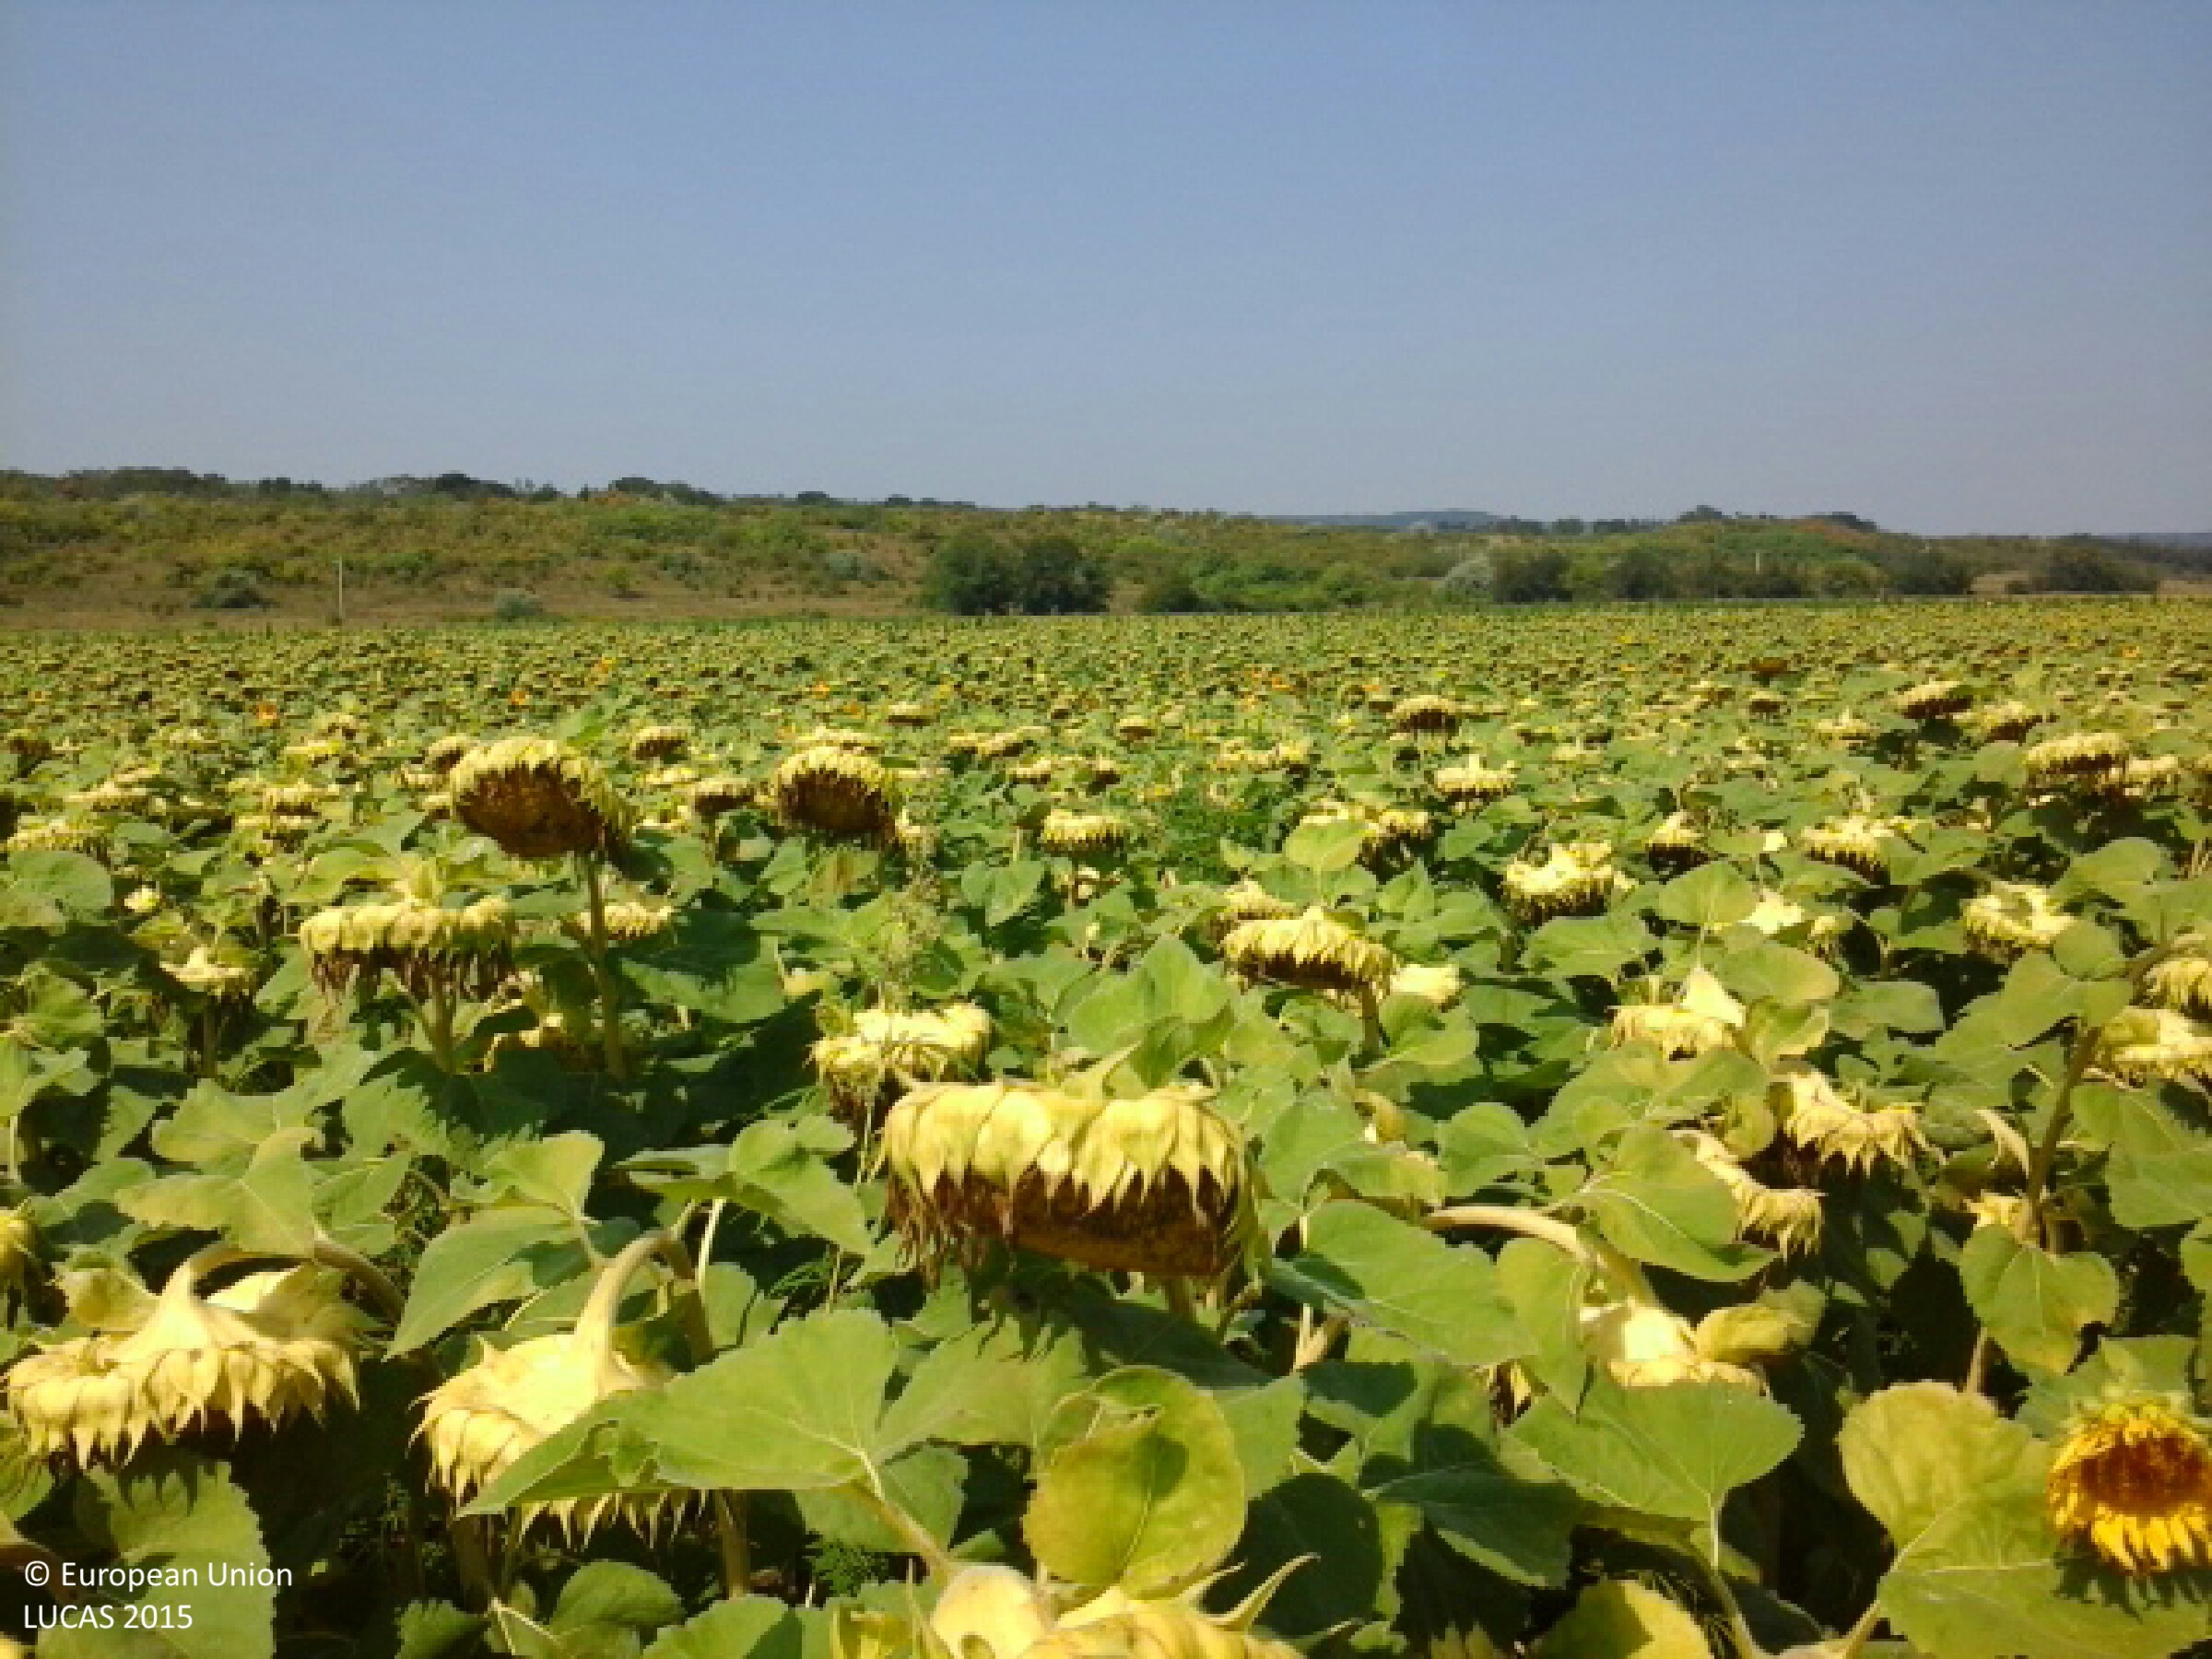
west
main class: Cropland
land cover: Sunflower
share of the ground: > 75 %
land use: Agriculture (excluding fallow land and kitchen gardens)
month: August
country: HU
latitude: 47.4414
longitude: 18.5137
